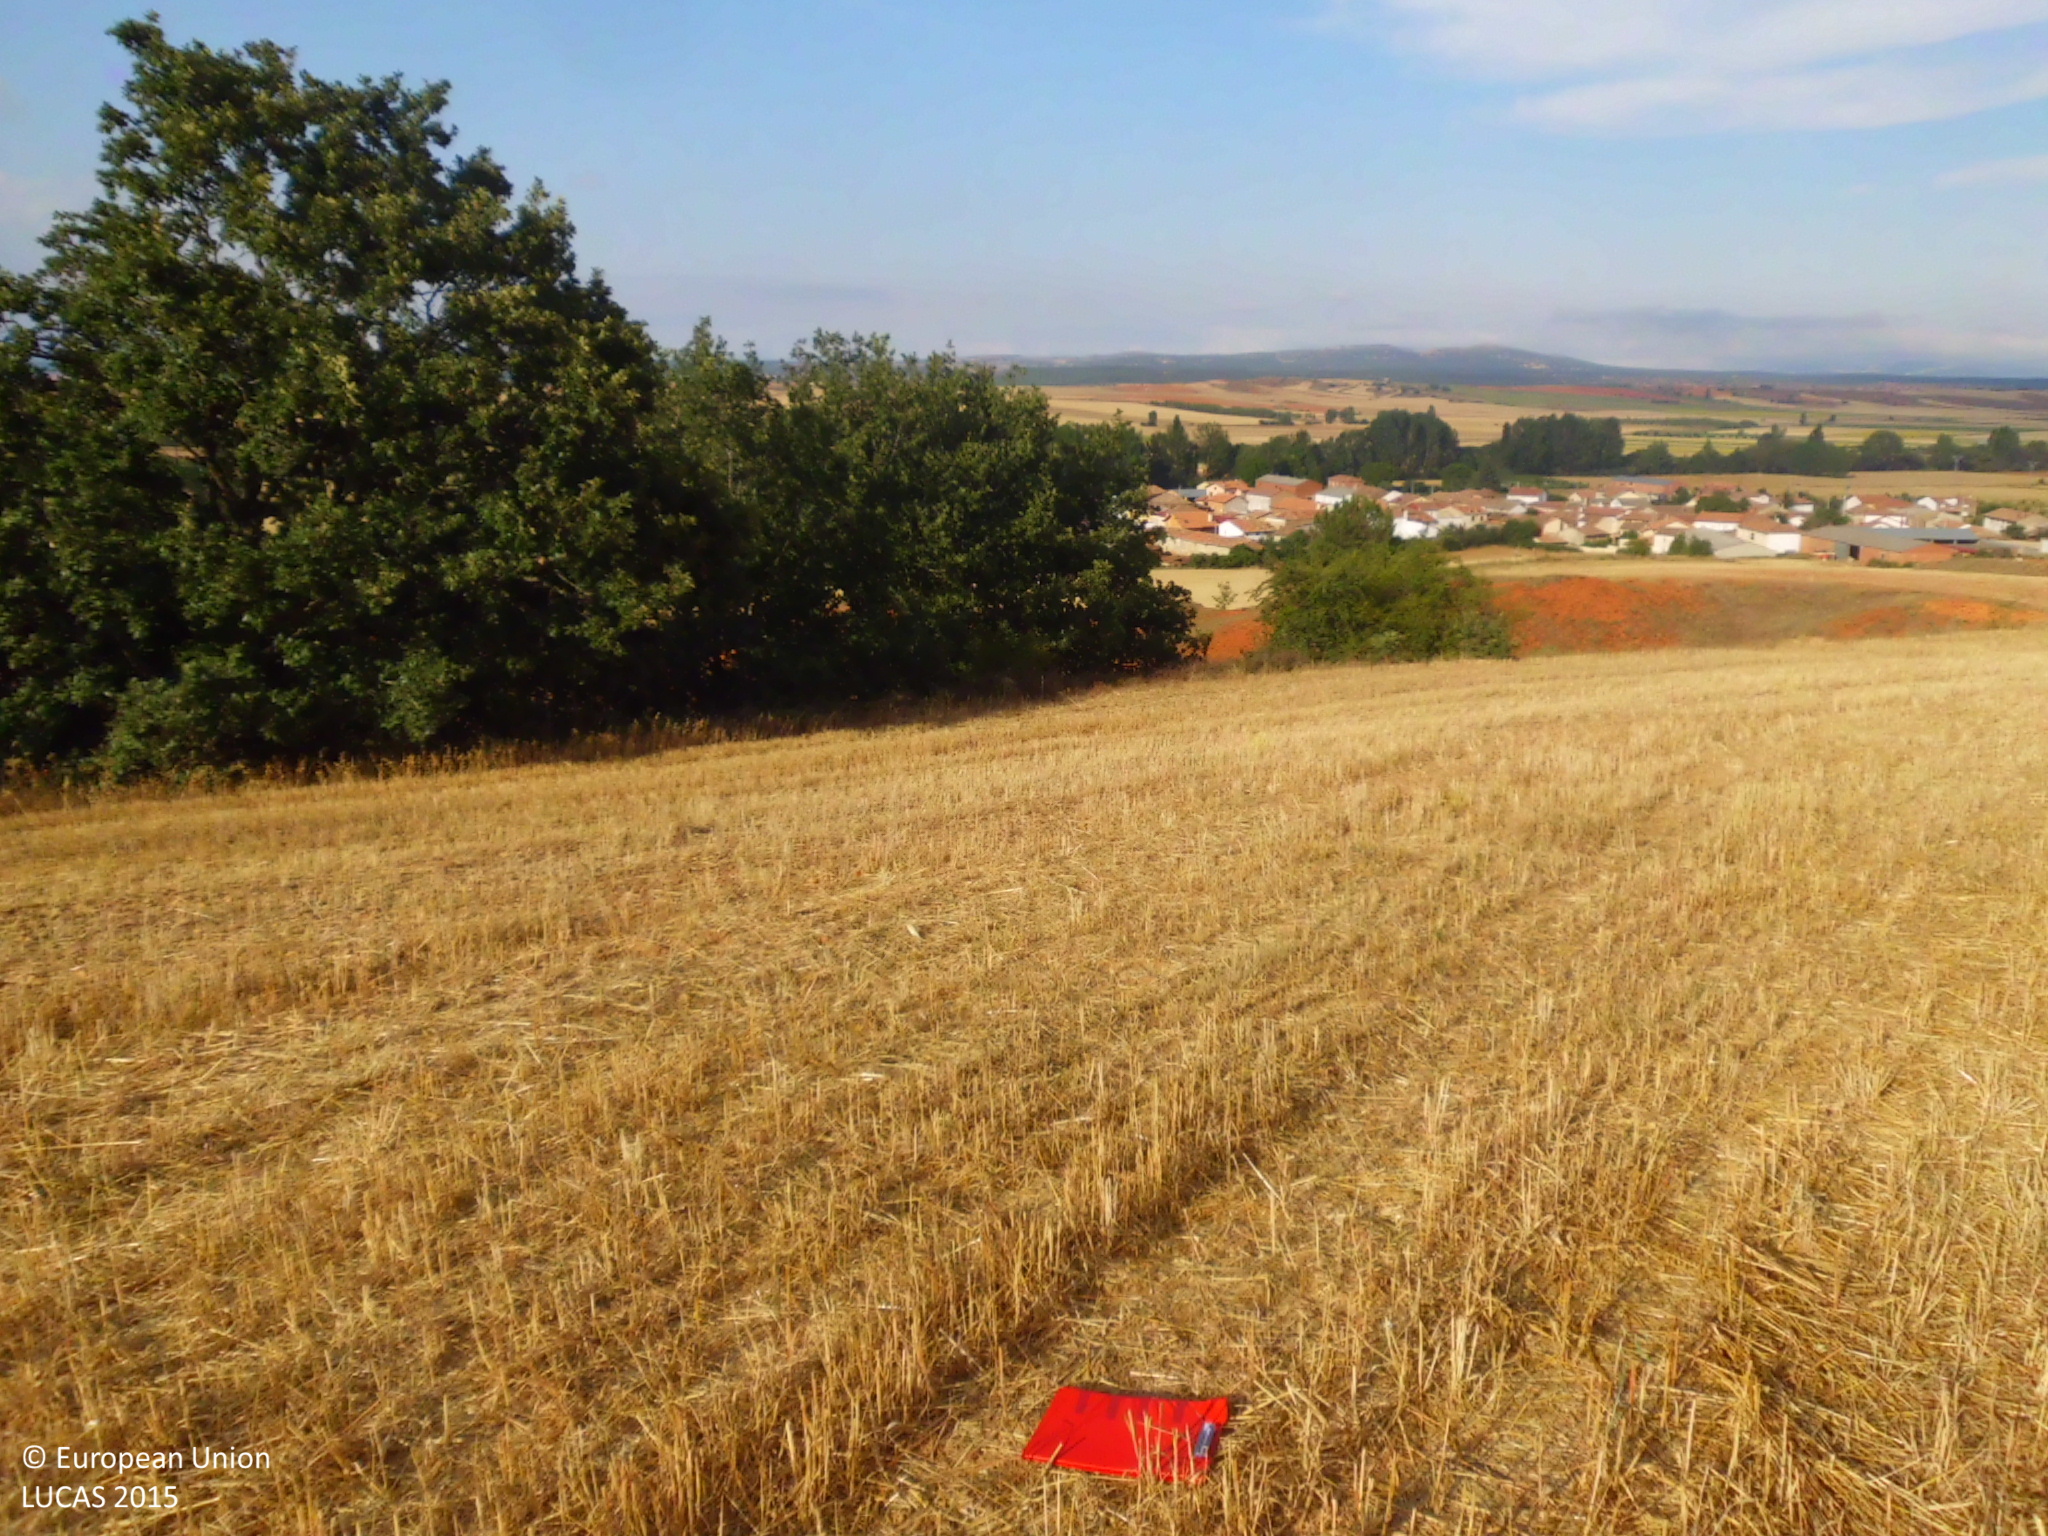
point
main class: Cropland
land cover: Oats
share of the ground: < 10 %
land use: Agriculture (excluding fallow land and kitchen gardens)
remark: Harvested field
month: July
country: ES
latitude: 42.6897
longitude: -4.4672
